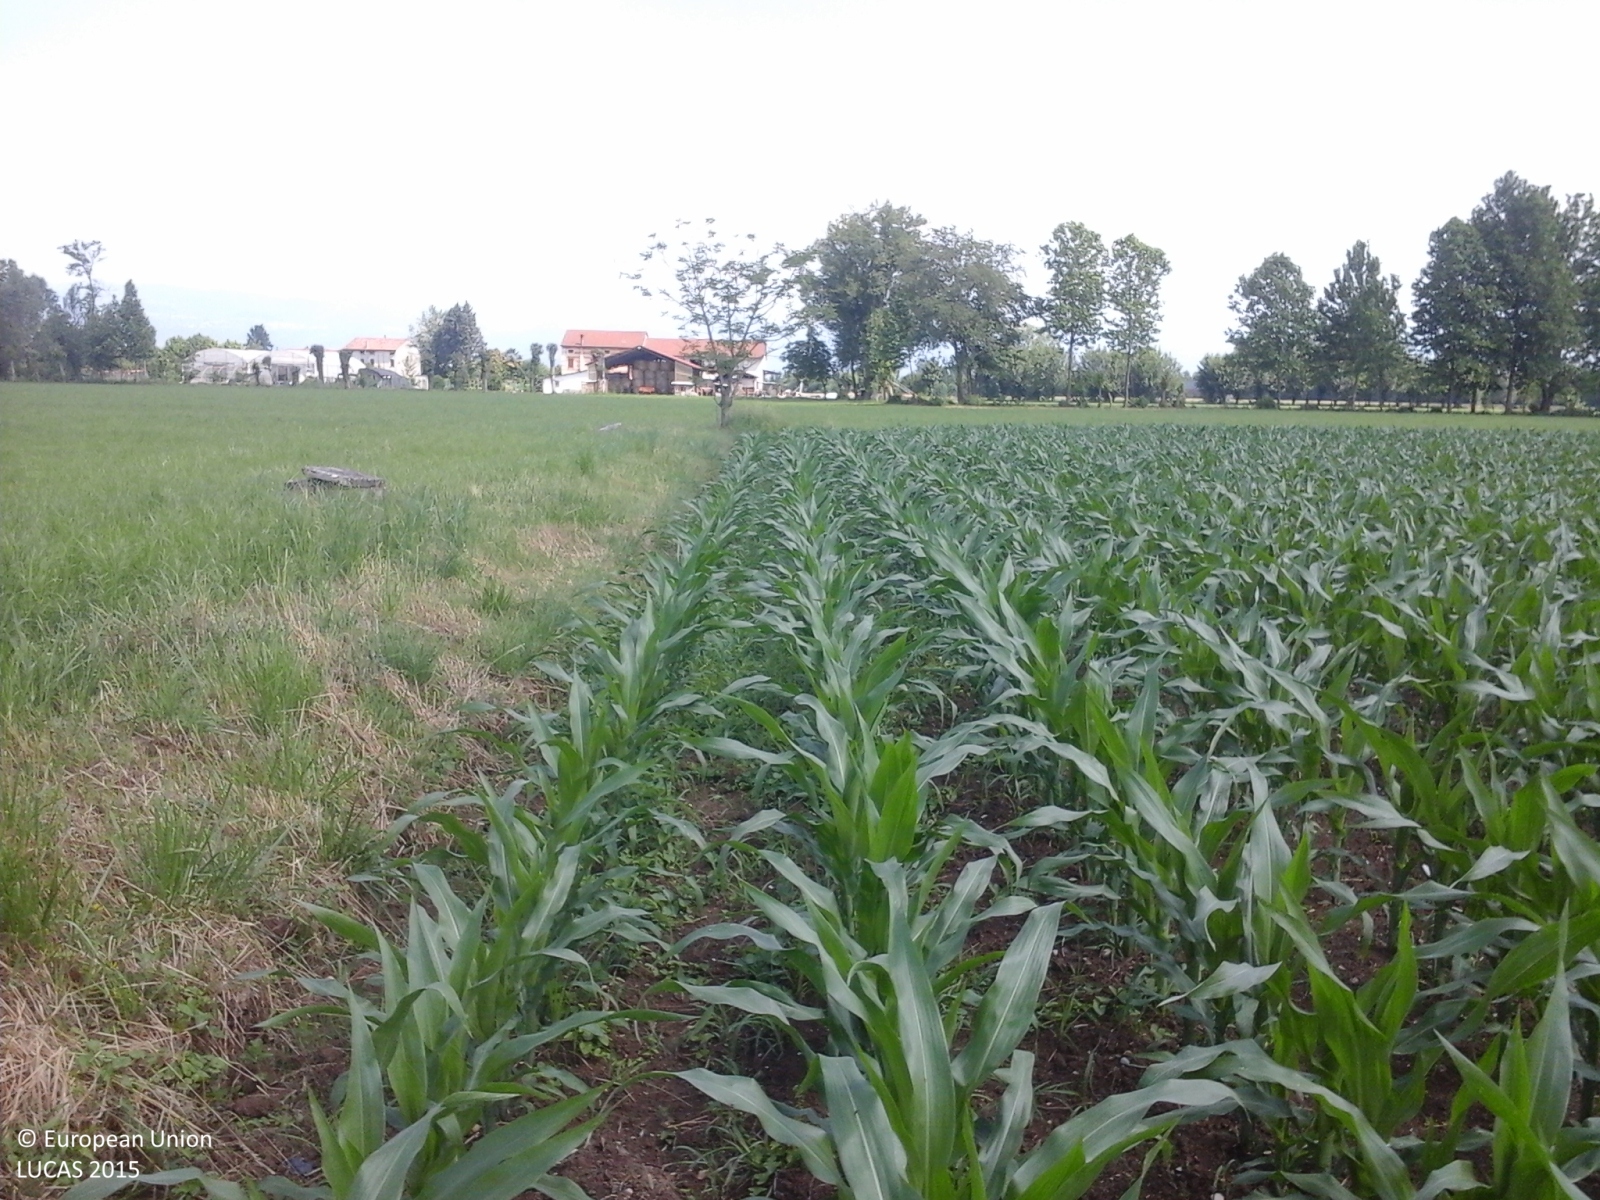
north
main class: Cropland
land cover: Maize
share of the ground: 50 - 75 %
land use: Agriculture (excluding fallow land and kitchen gardens)
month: May
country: IT
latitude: 45.6181
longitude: 11.6261
